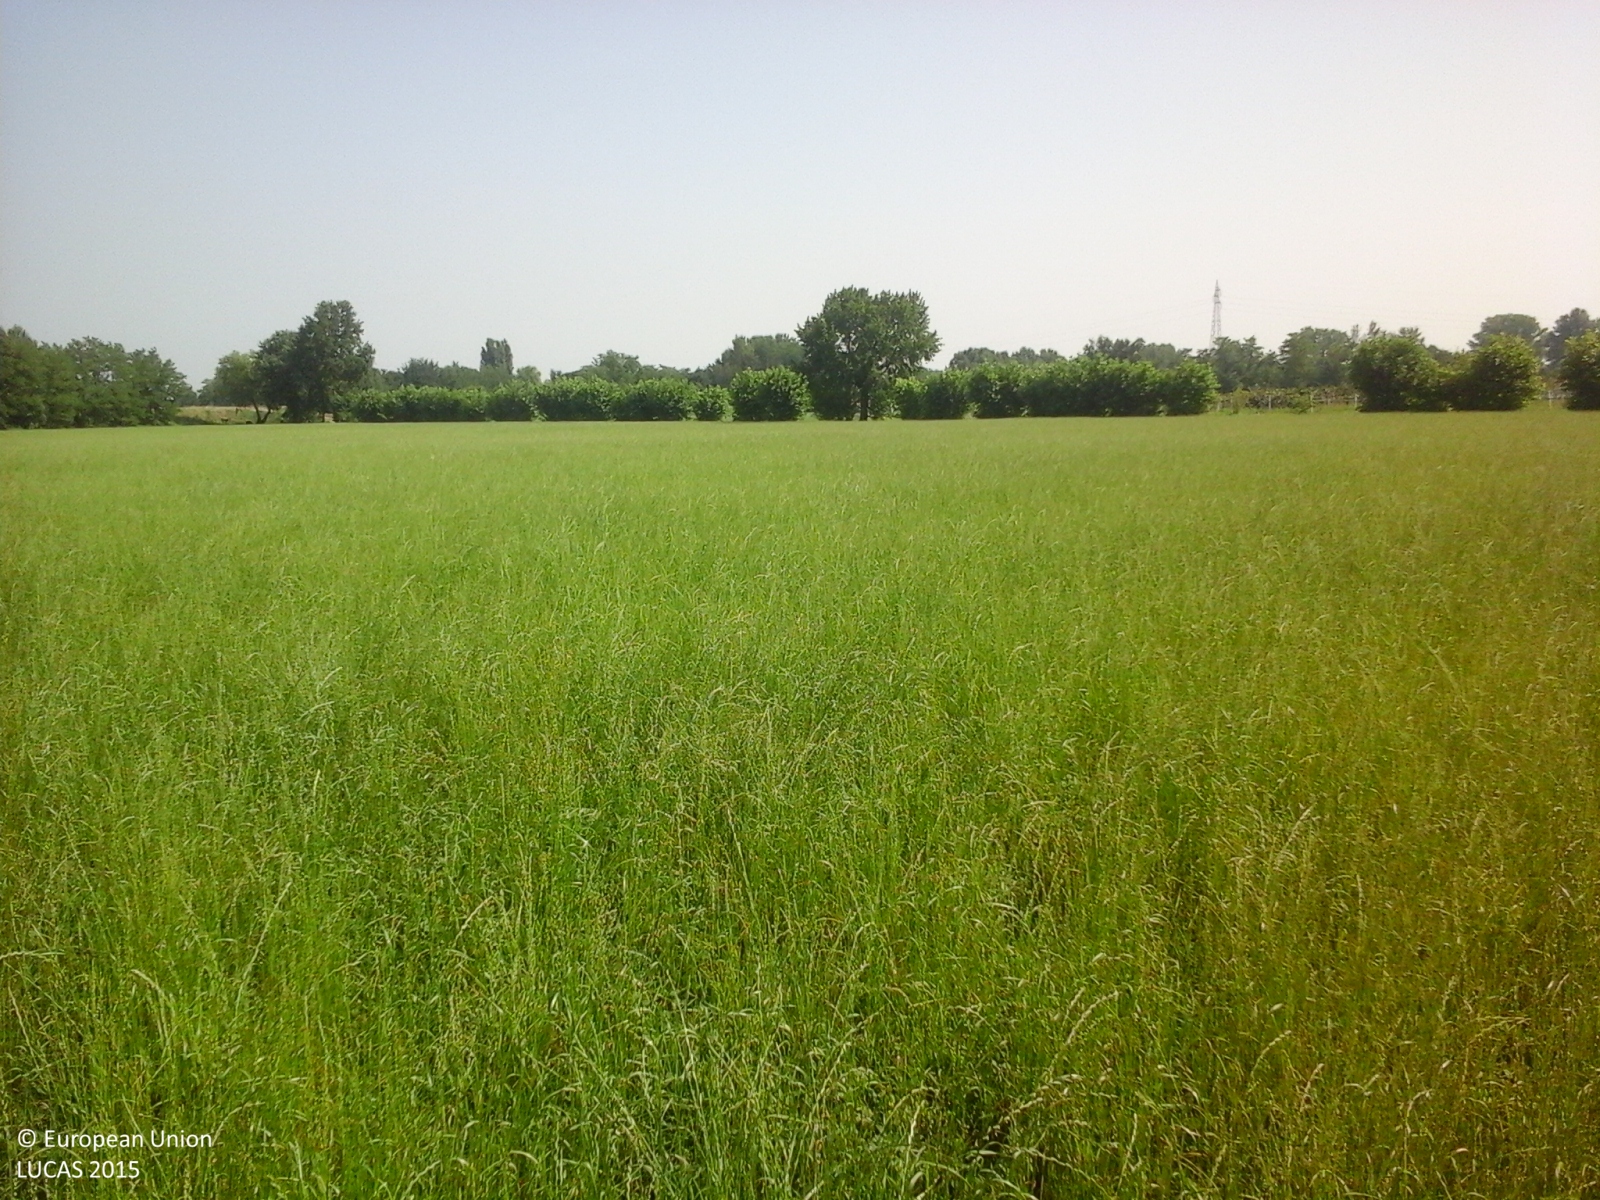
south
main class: Cropland
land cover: Temporary grasslands
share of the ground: > 75 %
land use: Agriculture (excluding fallow land and kitchen gardens)
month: July
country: IT
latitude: 45.2315
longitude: 10.7247
